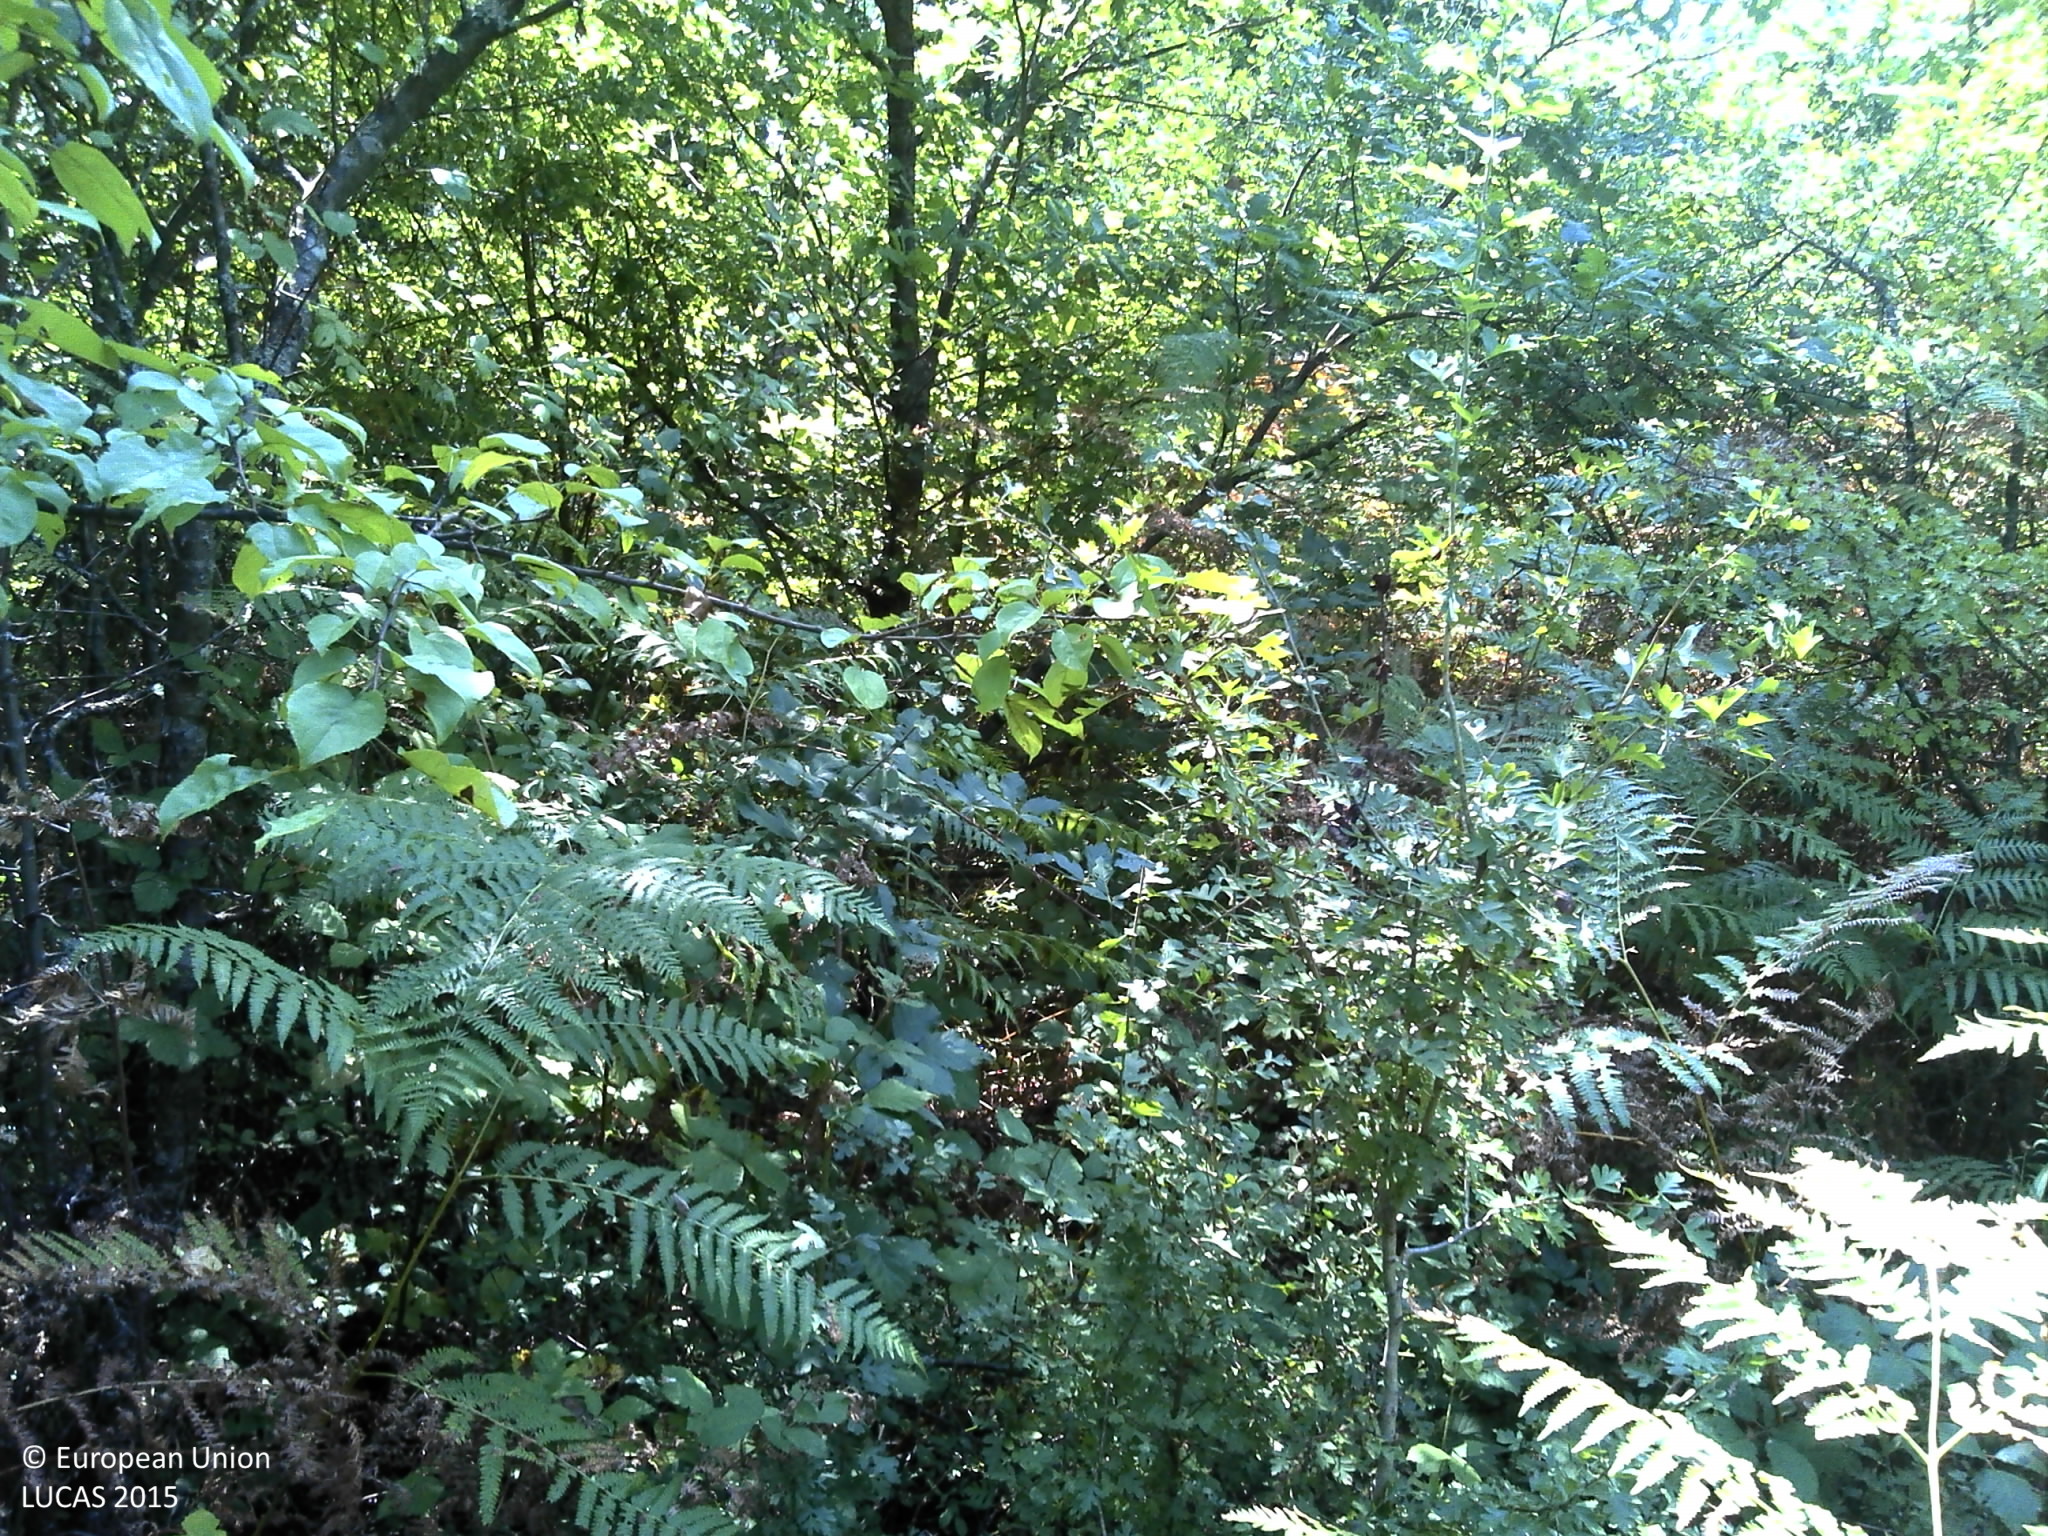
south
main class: Woodland
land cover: Broadleaved woodland
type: acidophilous oak and oak-birch forest
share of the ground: > 75 %
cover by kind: broadleaved forest trees 100 %
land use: Forestry
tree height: > 5 m
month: August
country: HR
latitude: 45.1465
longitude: 16.1137
